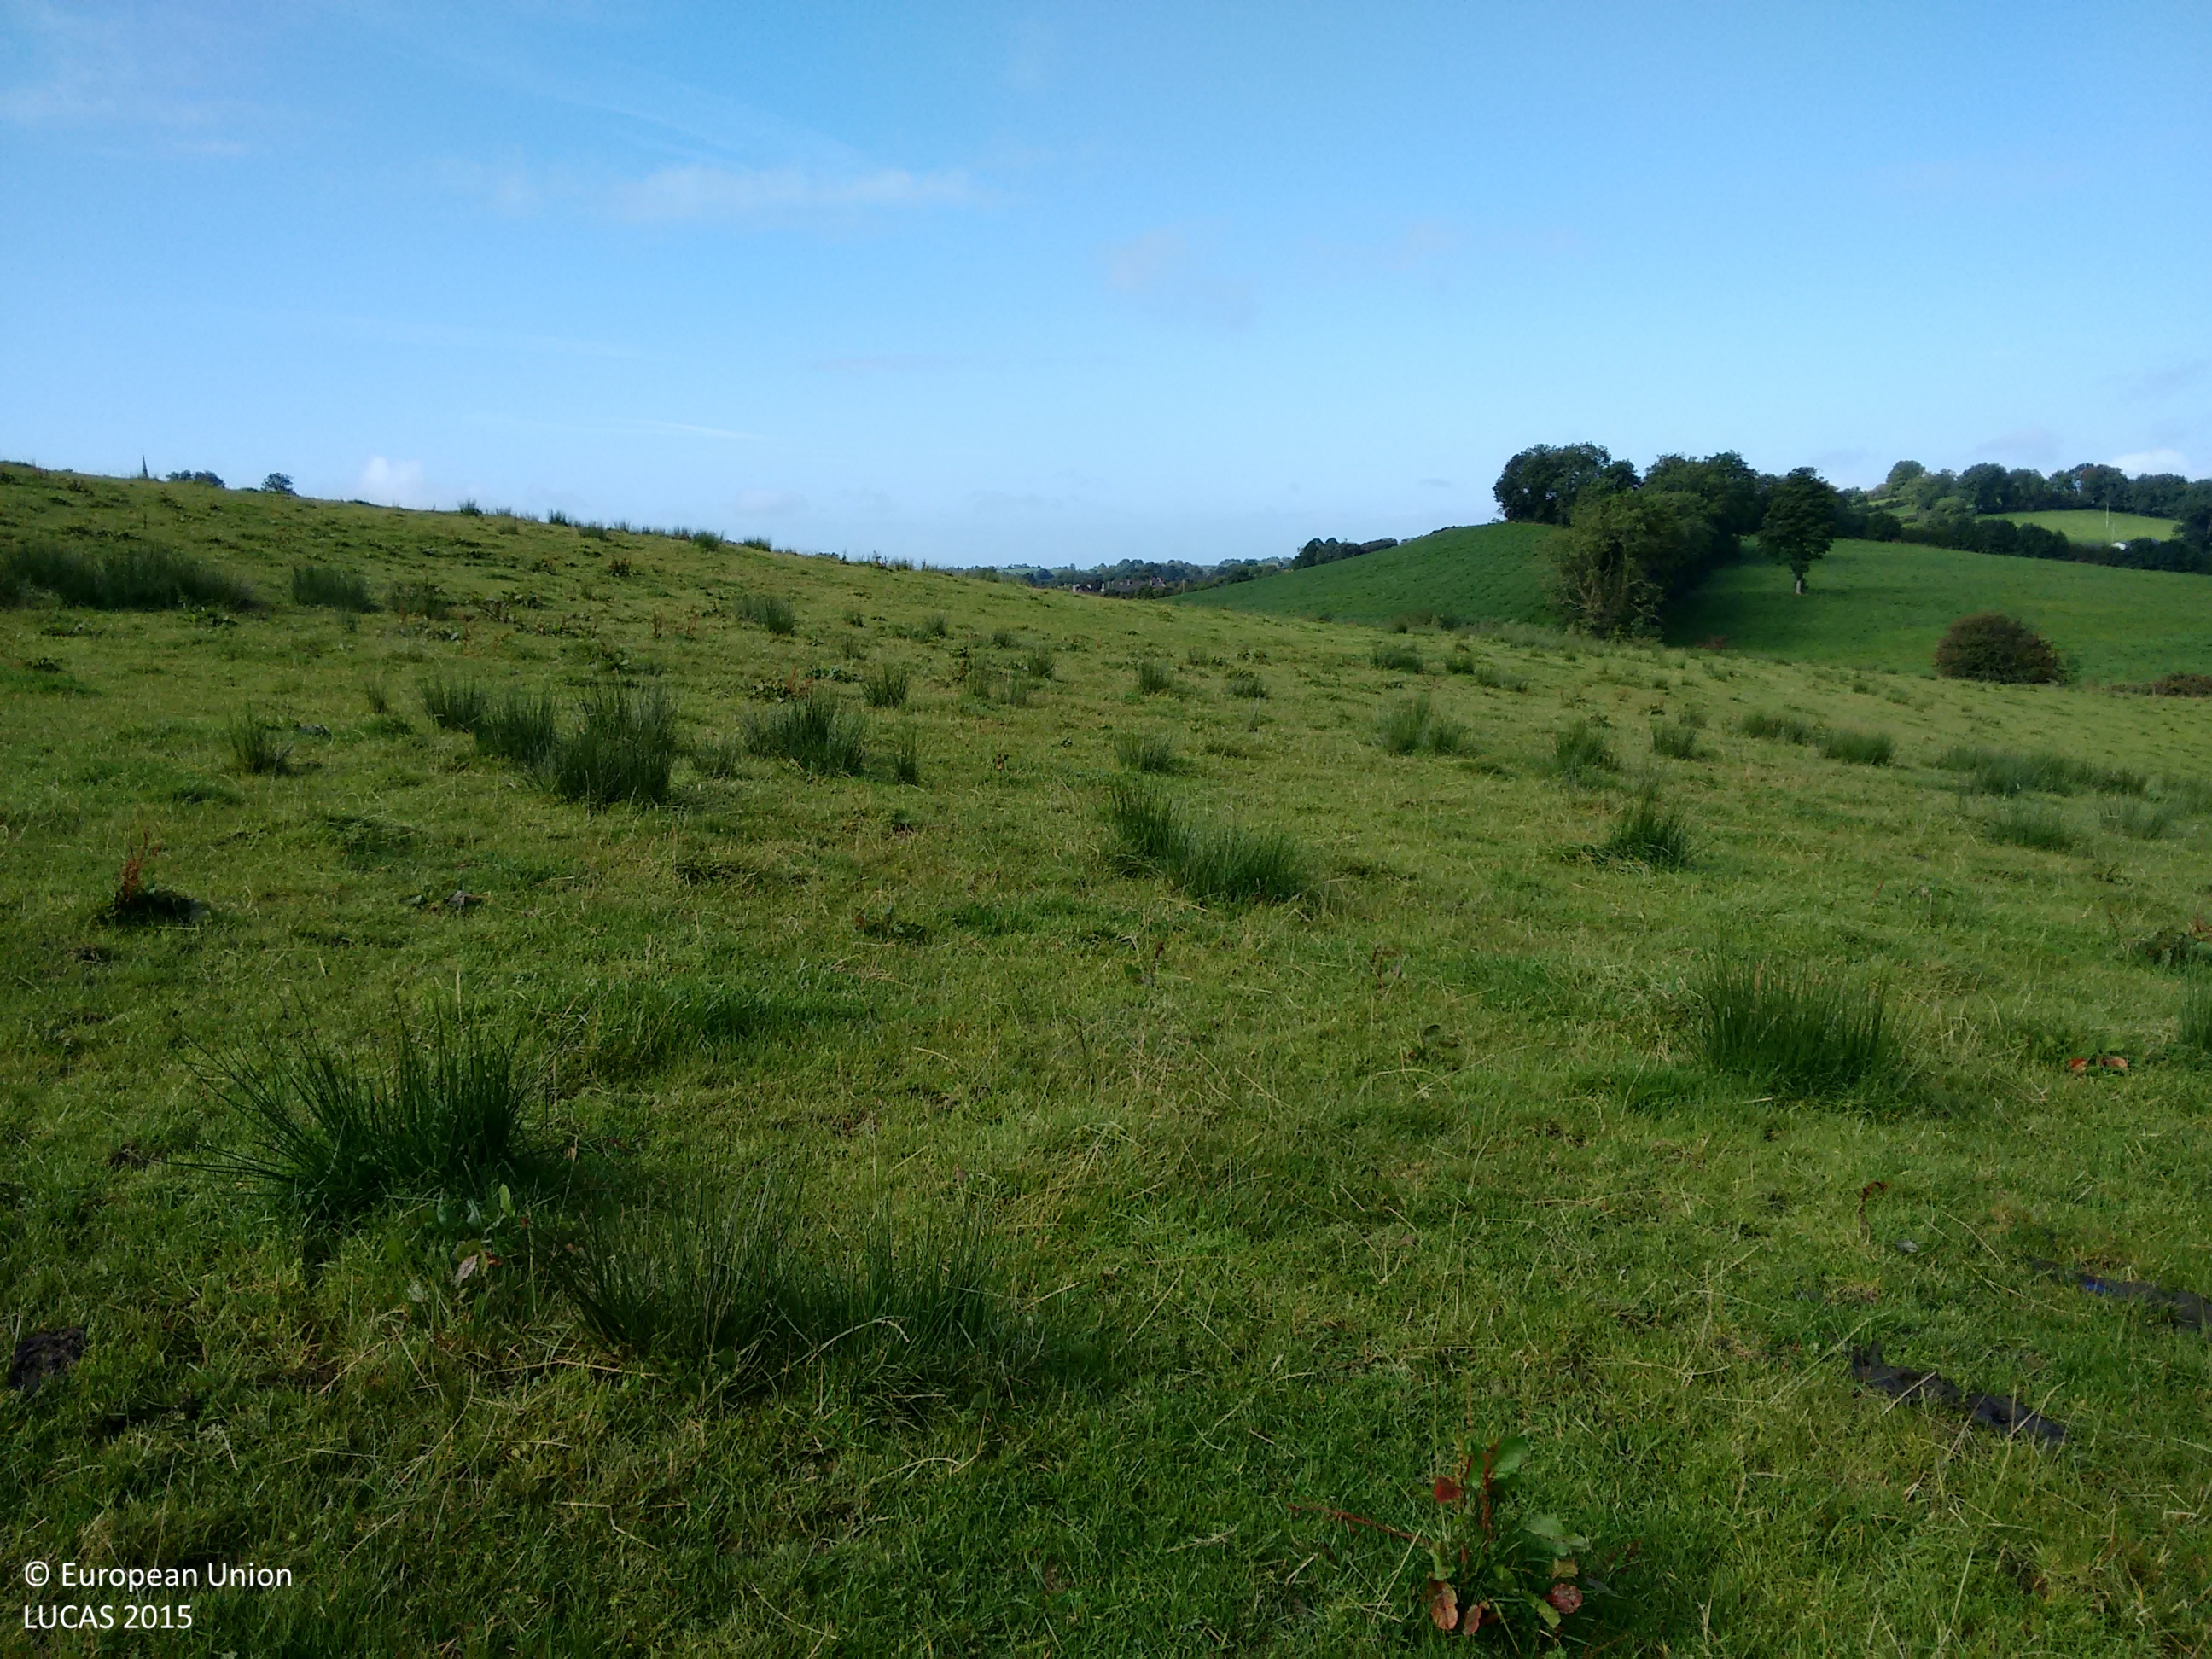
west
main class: Grassland
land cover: Grassland without tree/shrub cover
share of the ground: > 75 %
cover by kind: herbaceous plants 100 %
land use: Agriculture (excluding fallow land and kitchen gardens)
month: September
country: IE
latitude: 54.1340
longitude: -6.8961
